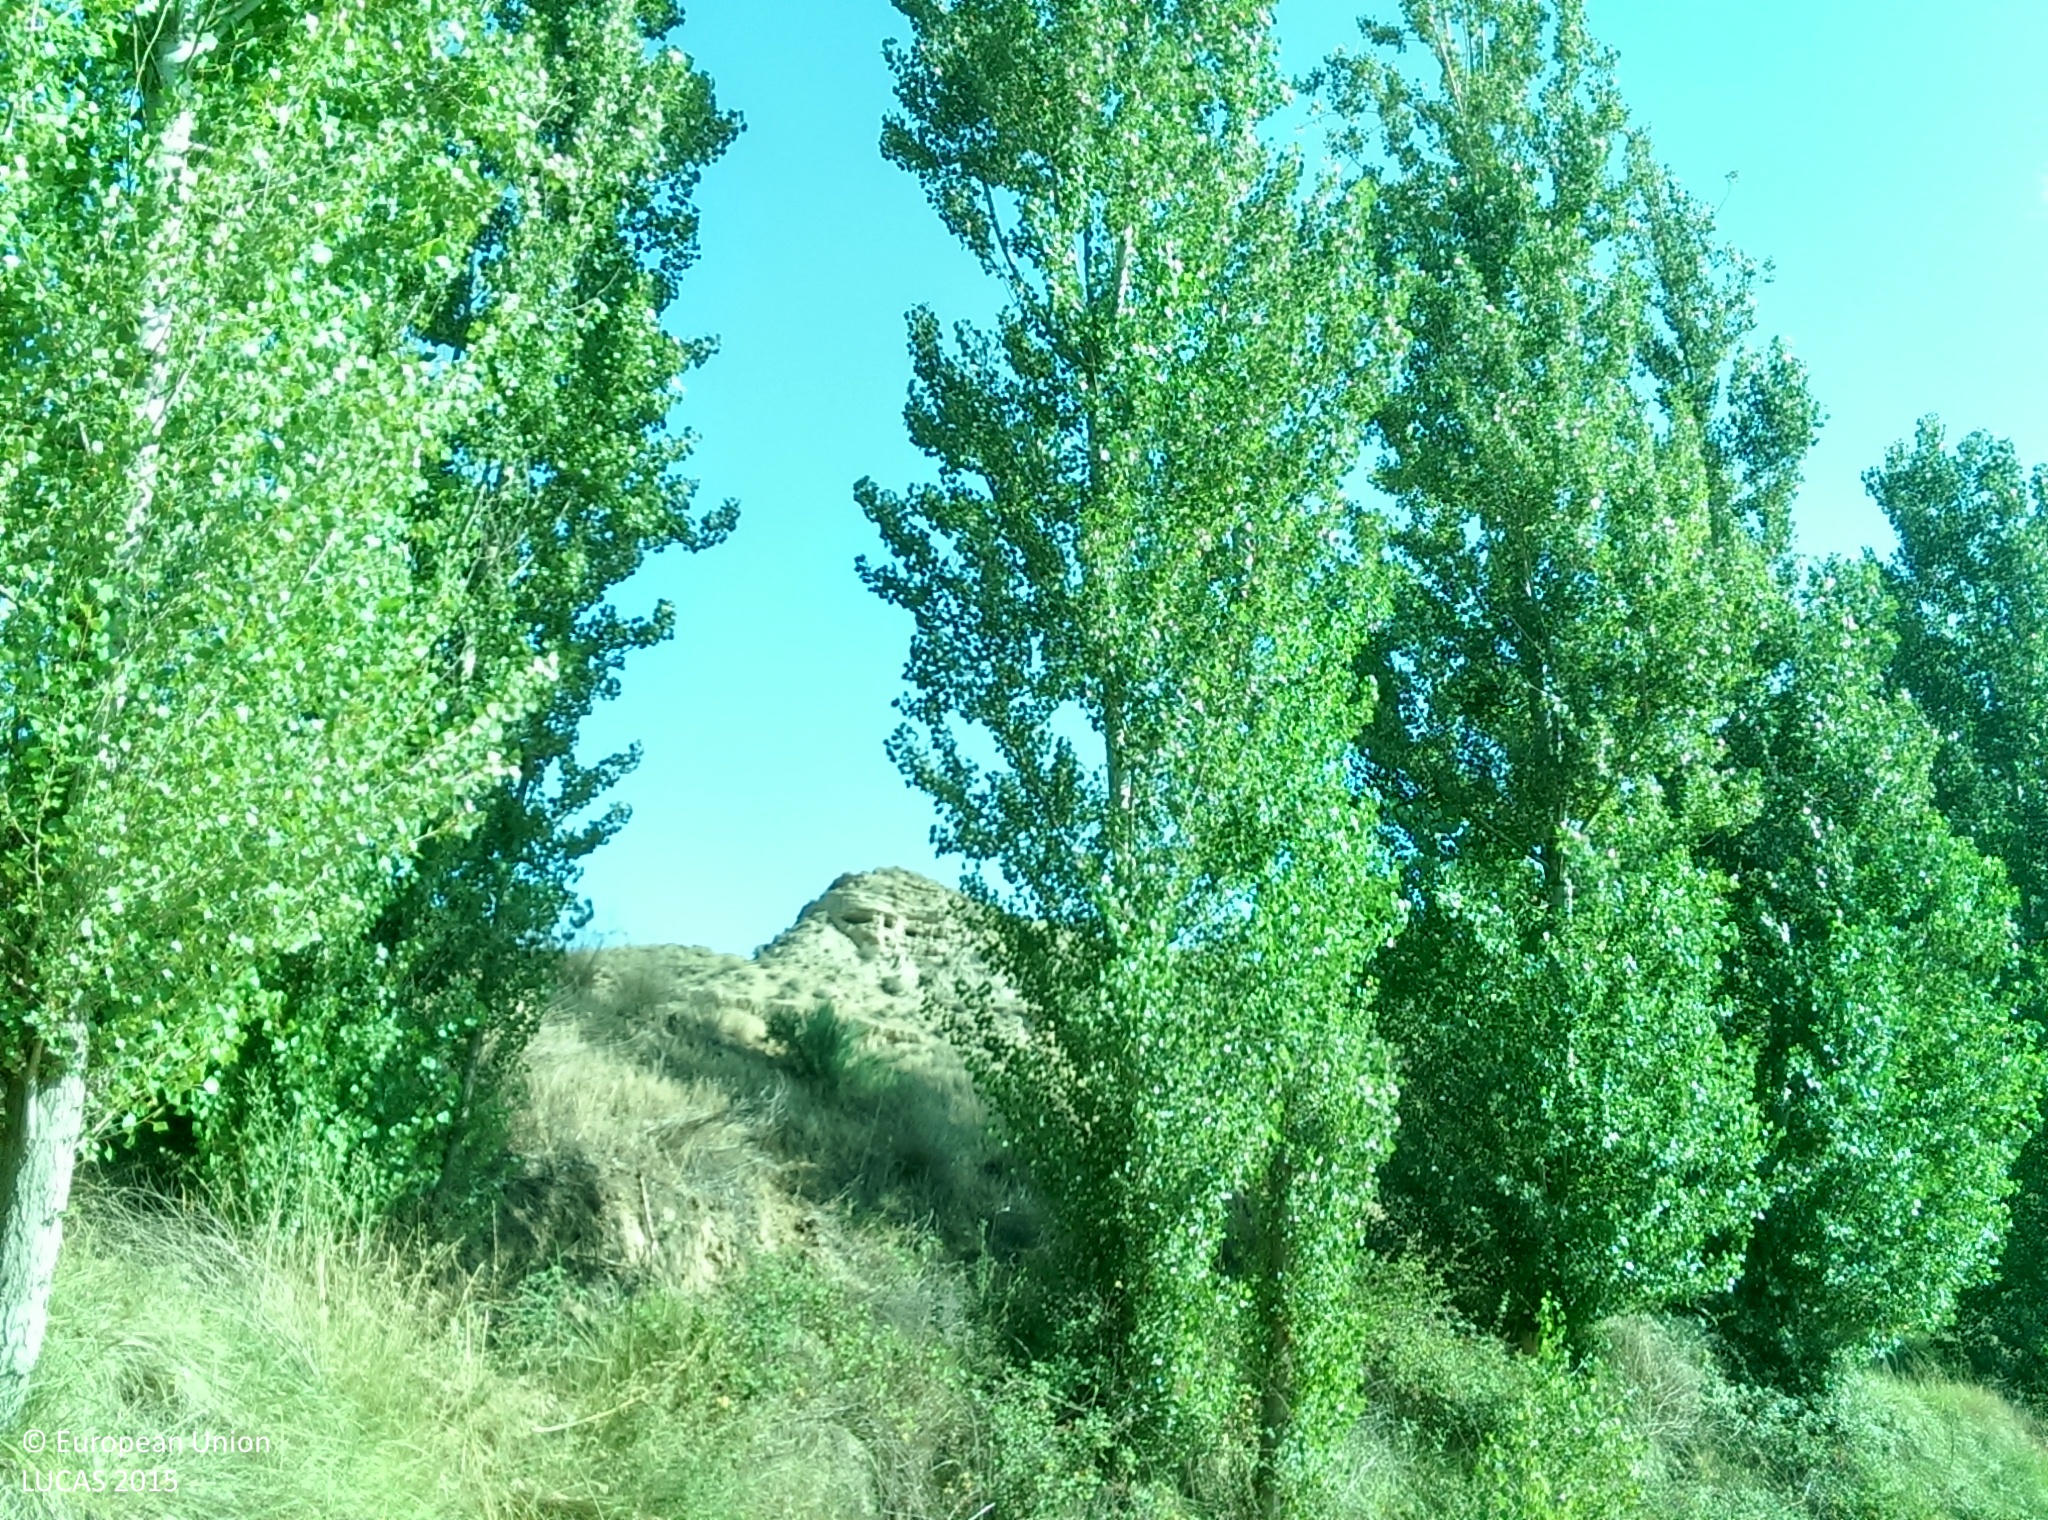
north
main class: Cropland
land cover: Barley
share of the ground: < 10 %
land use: Agriculture (excluding fallow land and kitchen gardens)
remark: Harvested field
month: July
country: ES
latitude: 37.3361
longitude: -3.2052
